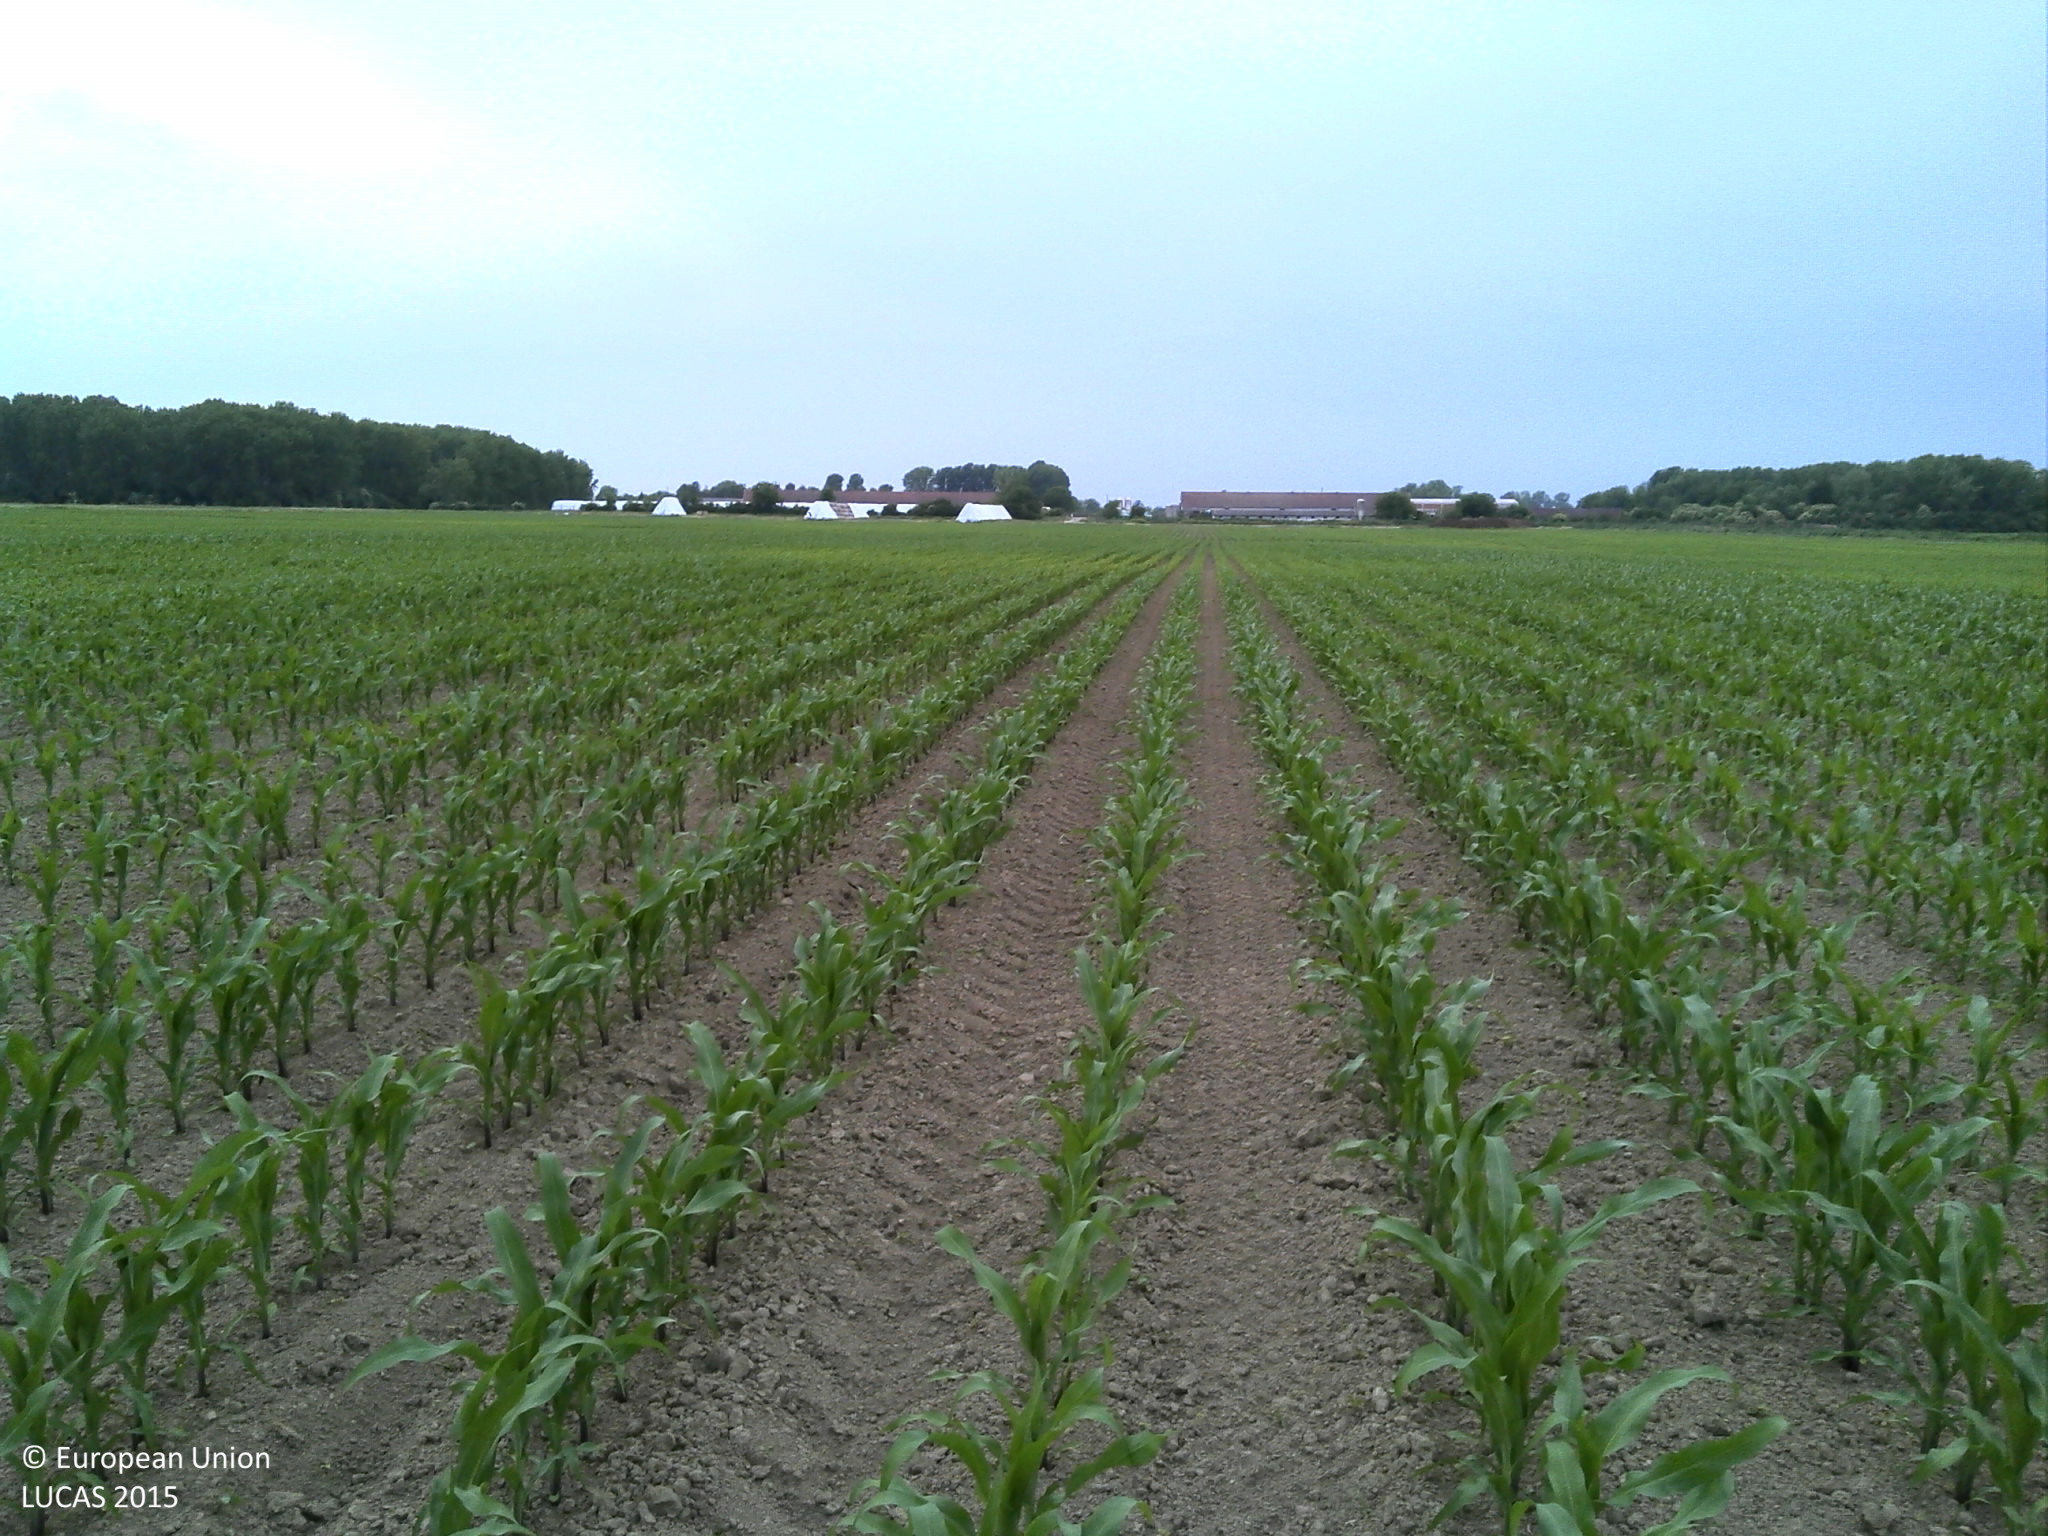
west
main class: Cropland
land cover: Maize
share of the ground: 25 - 50 %
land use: Agriculture (excluding fallow land and kitchen gardens)
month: May
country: HR
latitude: 45.5438
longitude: 18.4722
